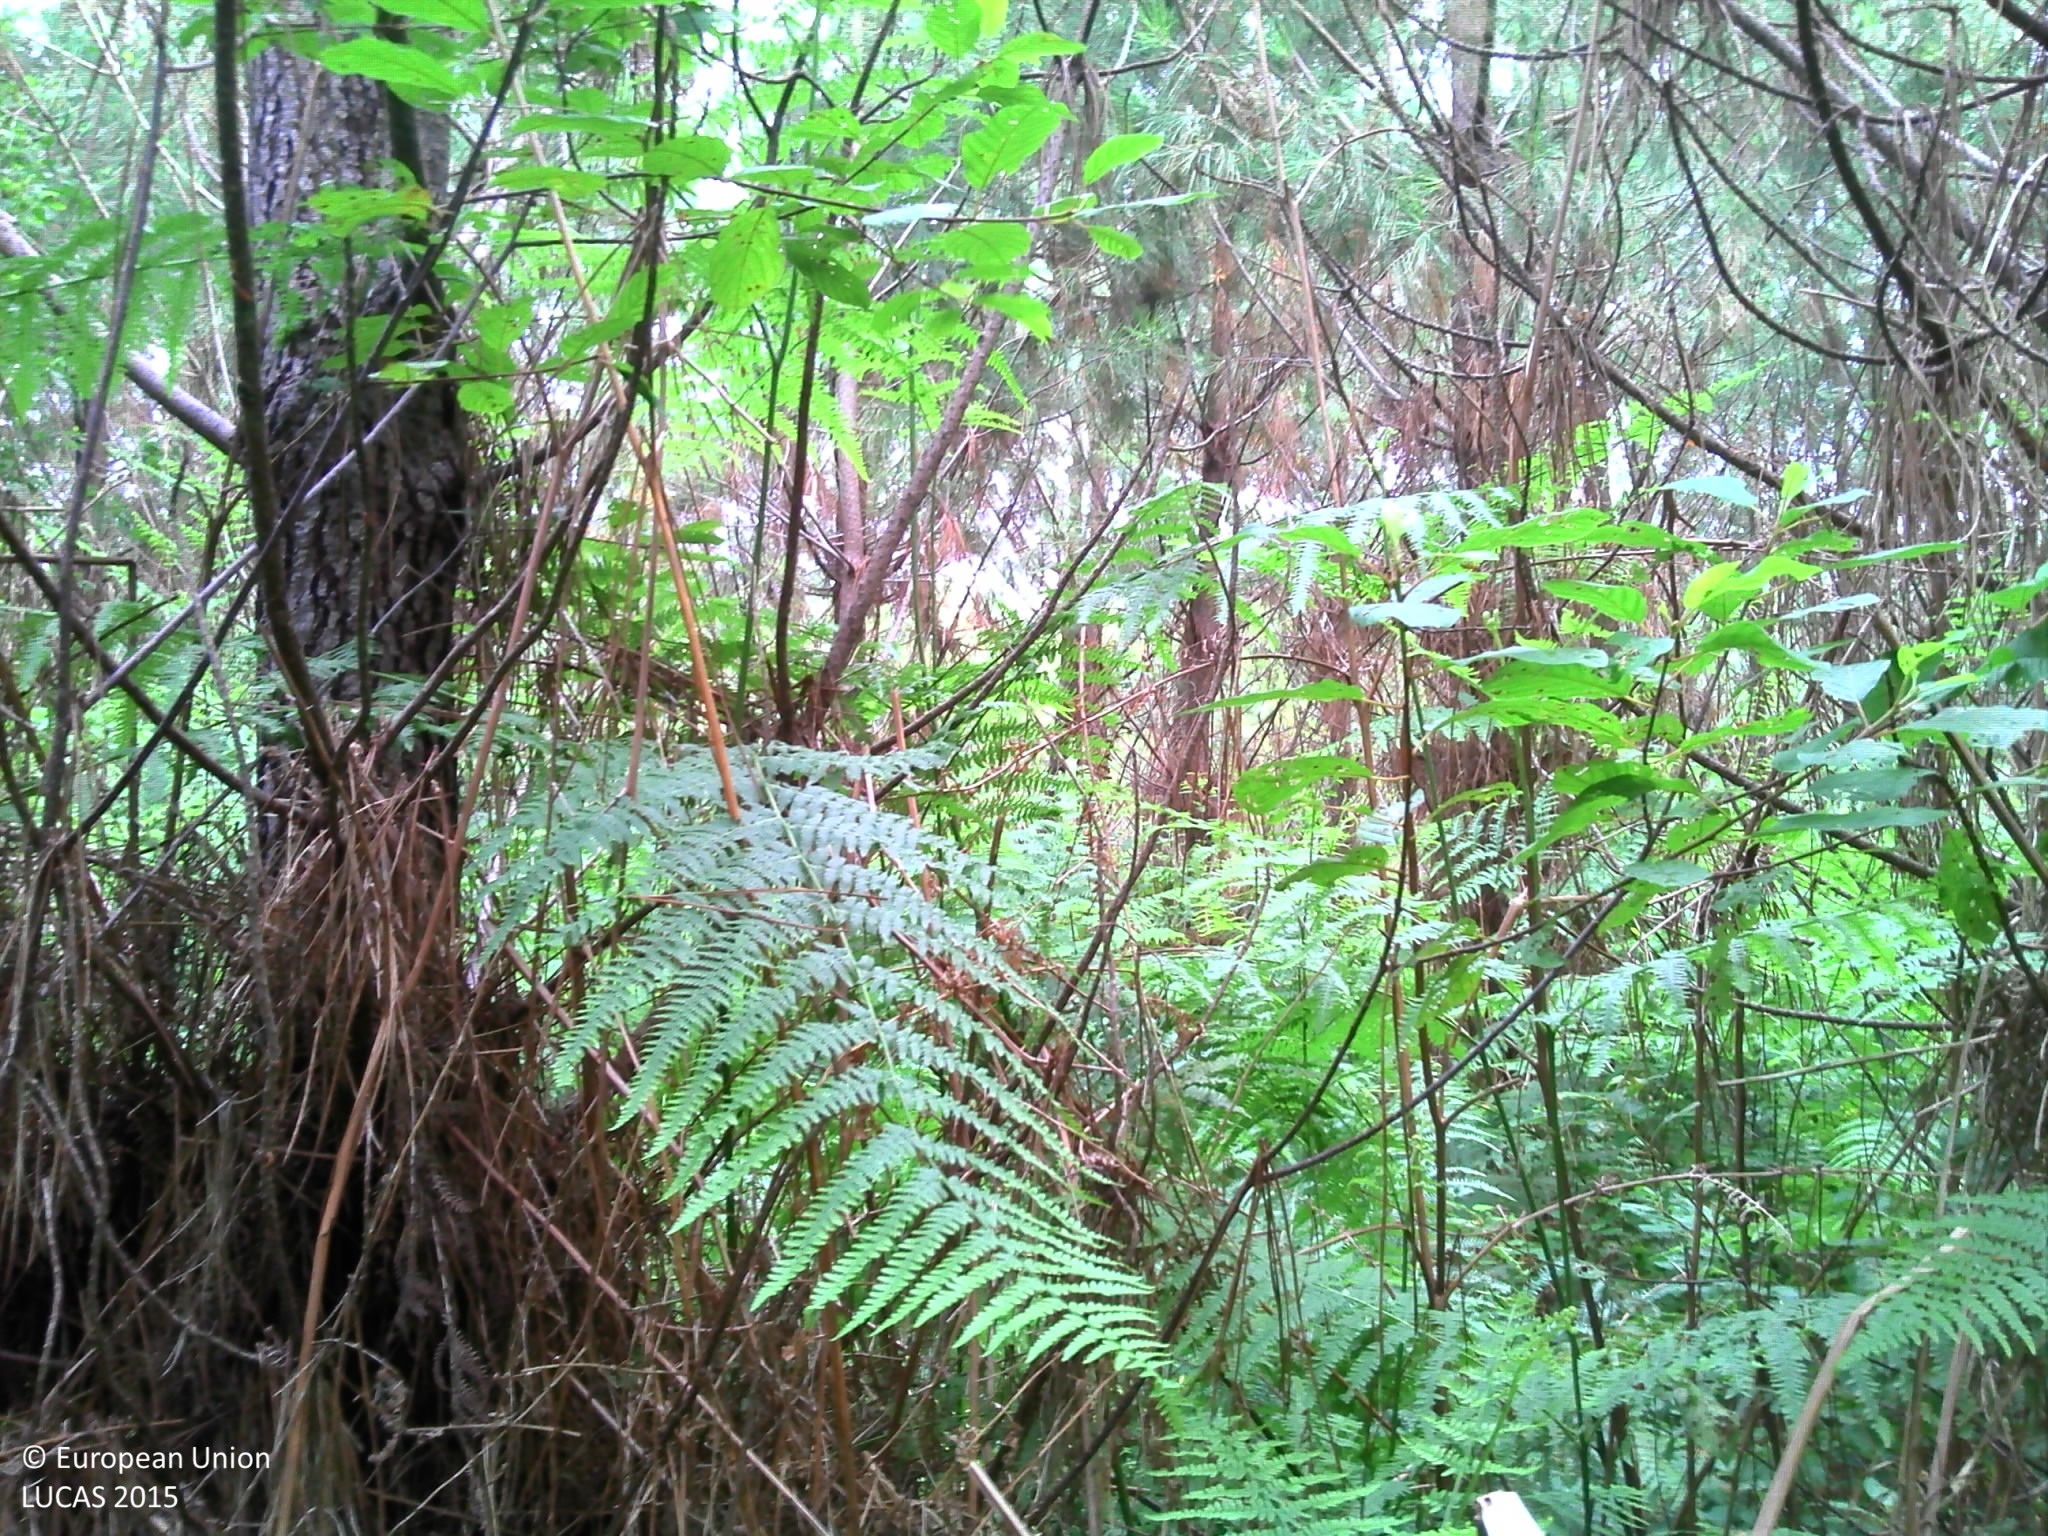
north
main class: Woodland
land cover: Pine dominated coniferous woodland
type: coniferous forest of the mediterranean region
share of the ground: > 75 %
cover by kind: coniferous forest trees 80 %, herbaceous plants 10 %, broadleaved forest trees 5 %, shrubs 5 %
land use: Forestry
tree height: > 5 m
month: July
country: FR
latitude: 43.6391
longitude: -1.3105
